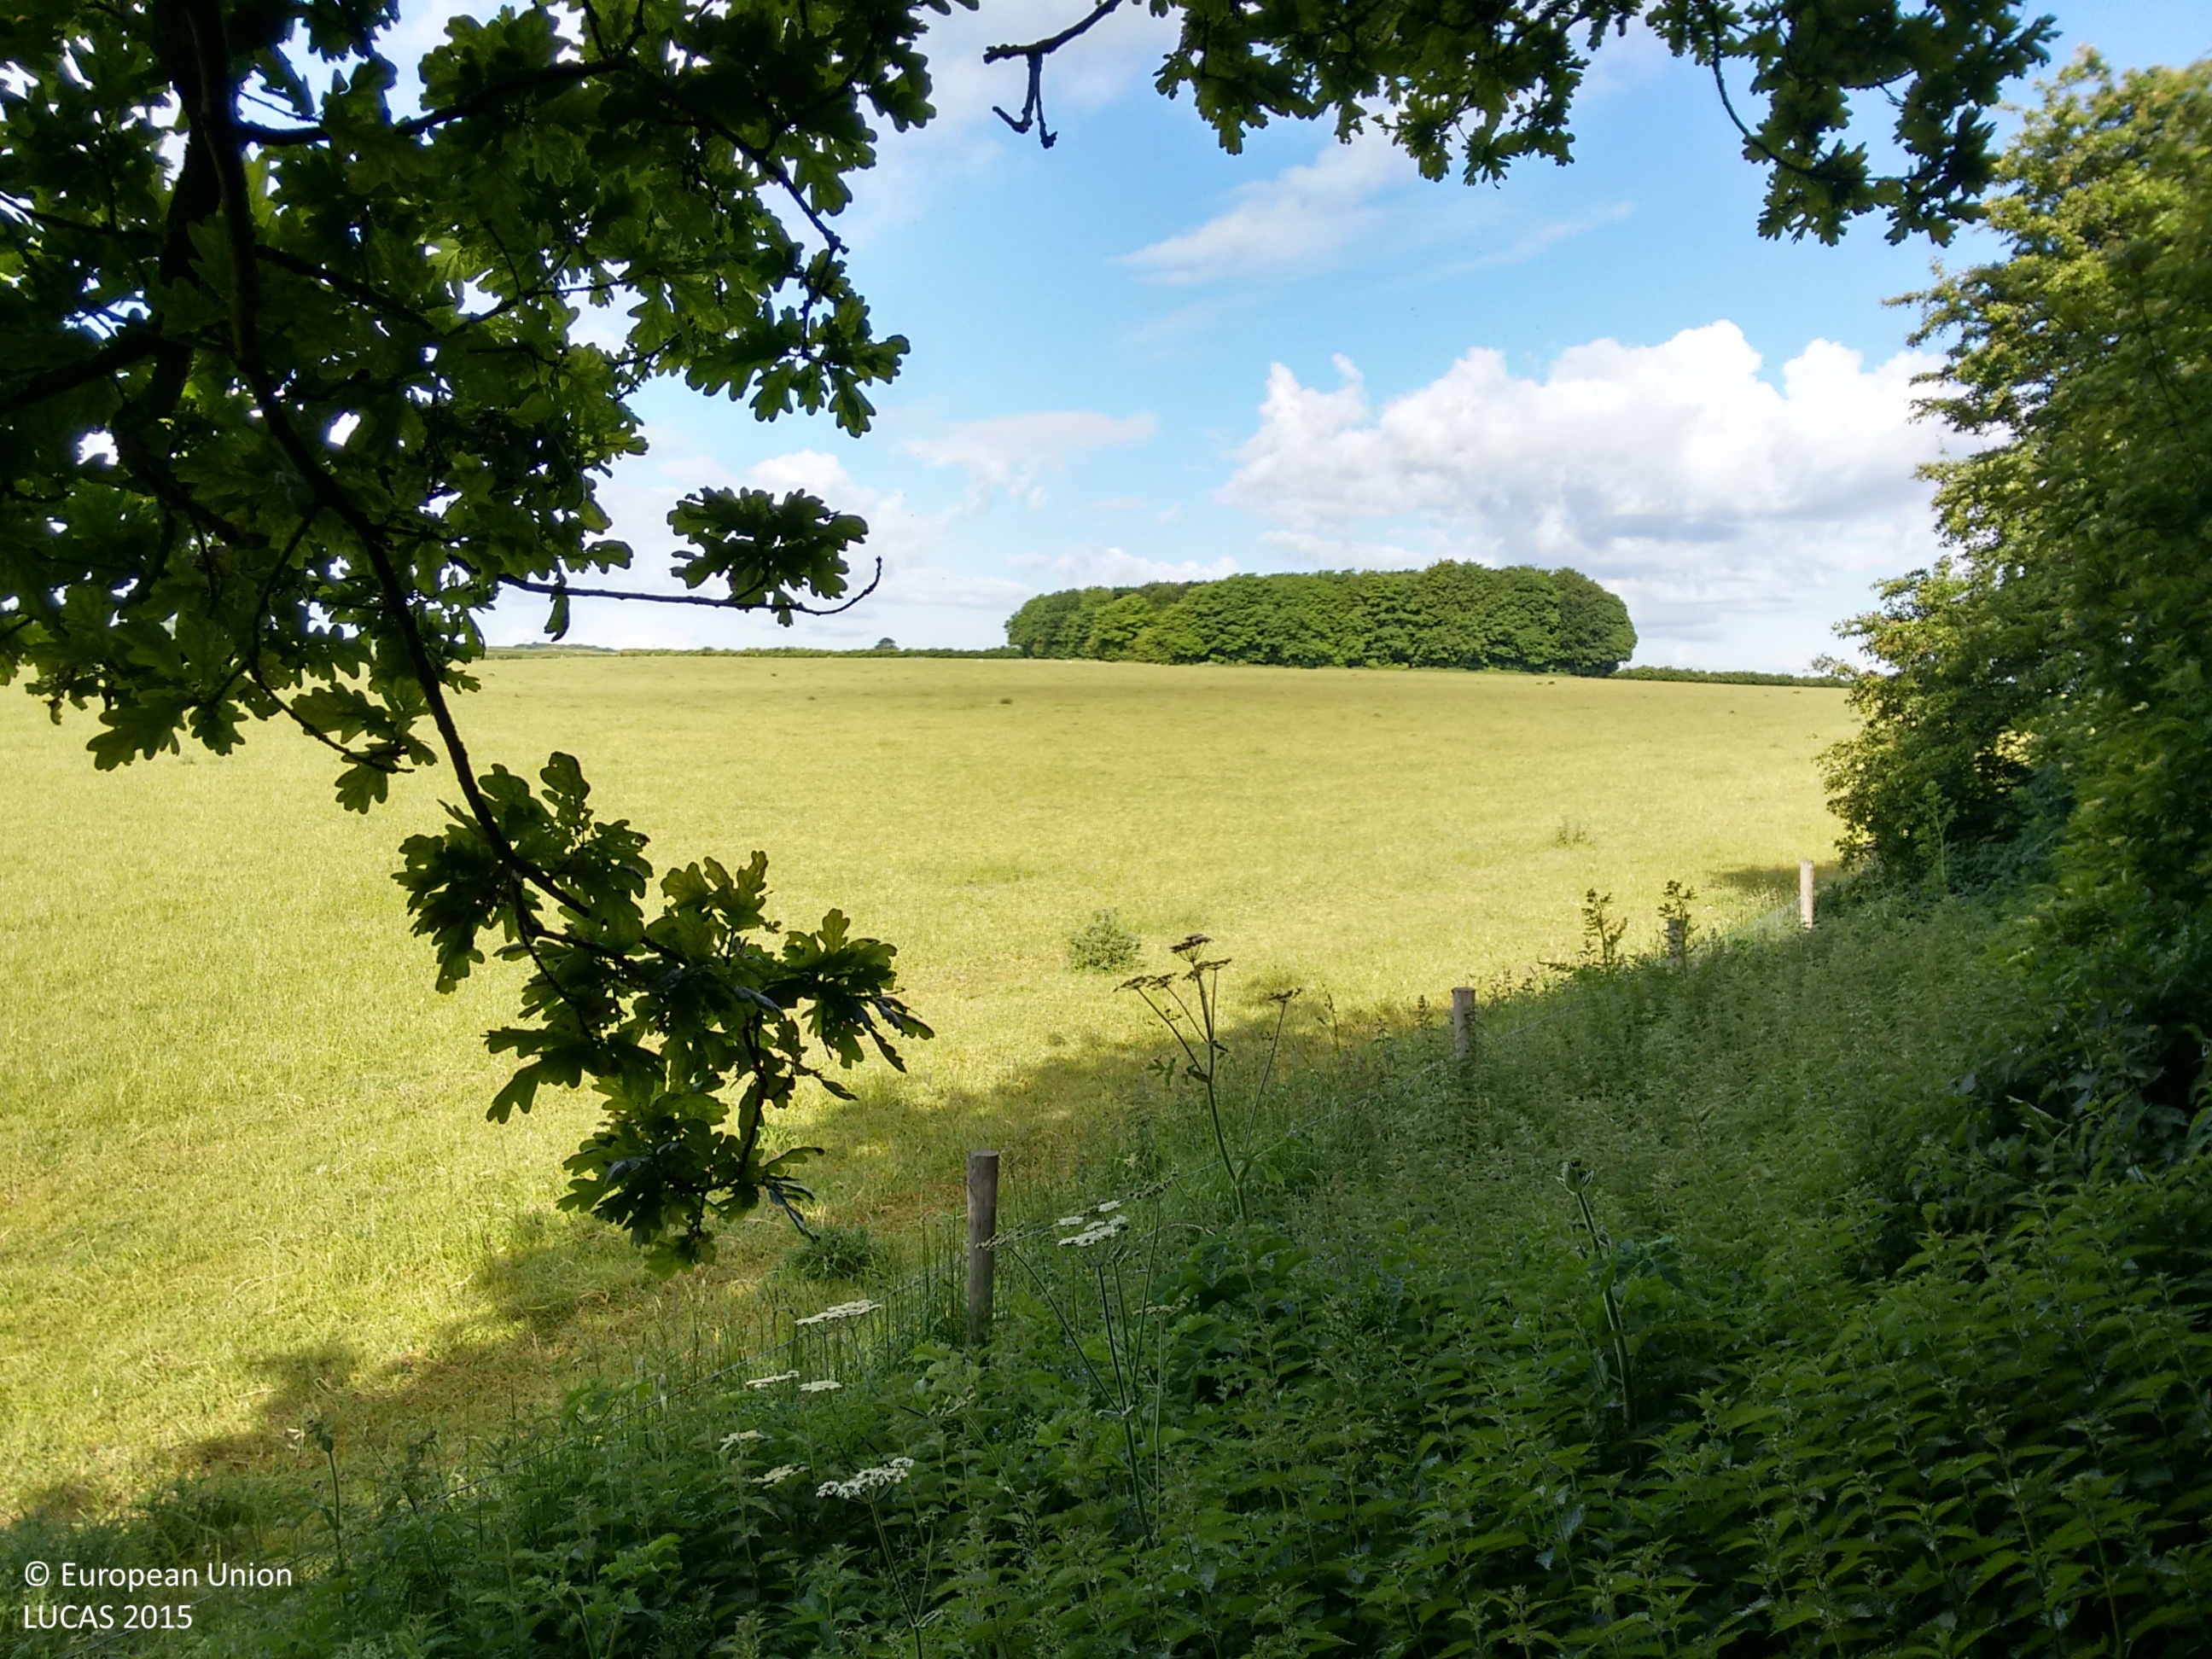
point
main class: Grassland
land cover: Grassland without tree/shrub cover
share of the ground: > 75 %
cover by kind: herbaceous plants 100 %
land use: Agriculture (excluding fallow land and kitchen gardens)
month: June
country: GB
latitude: 53.8890
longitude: -1.2907
